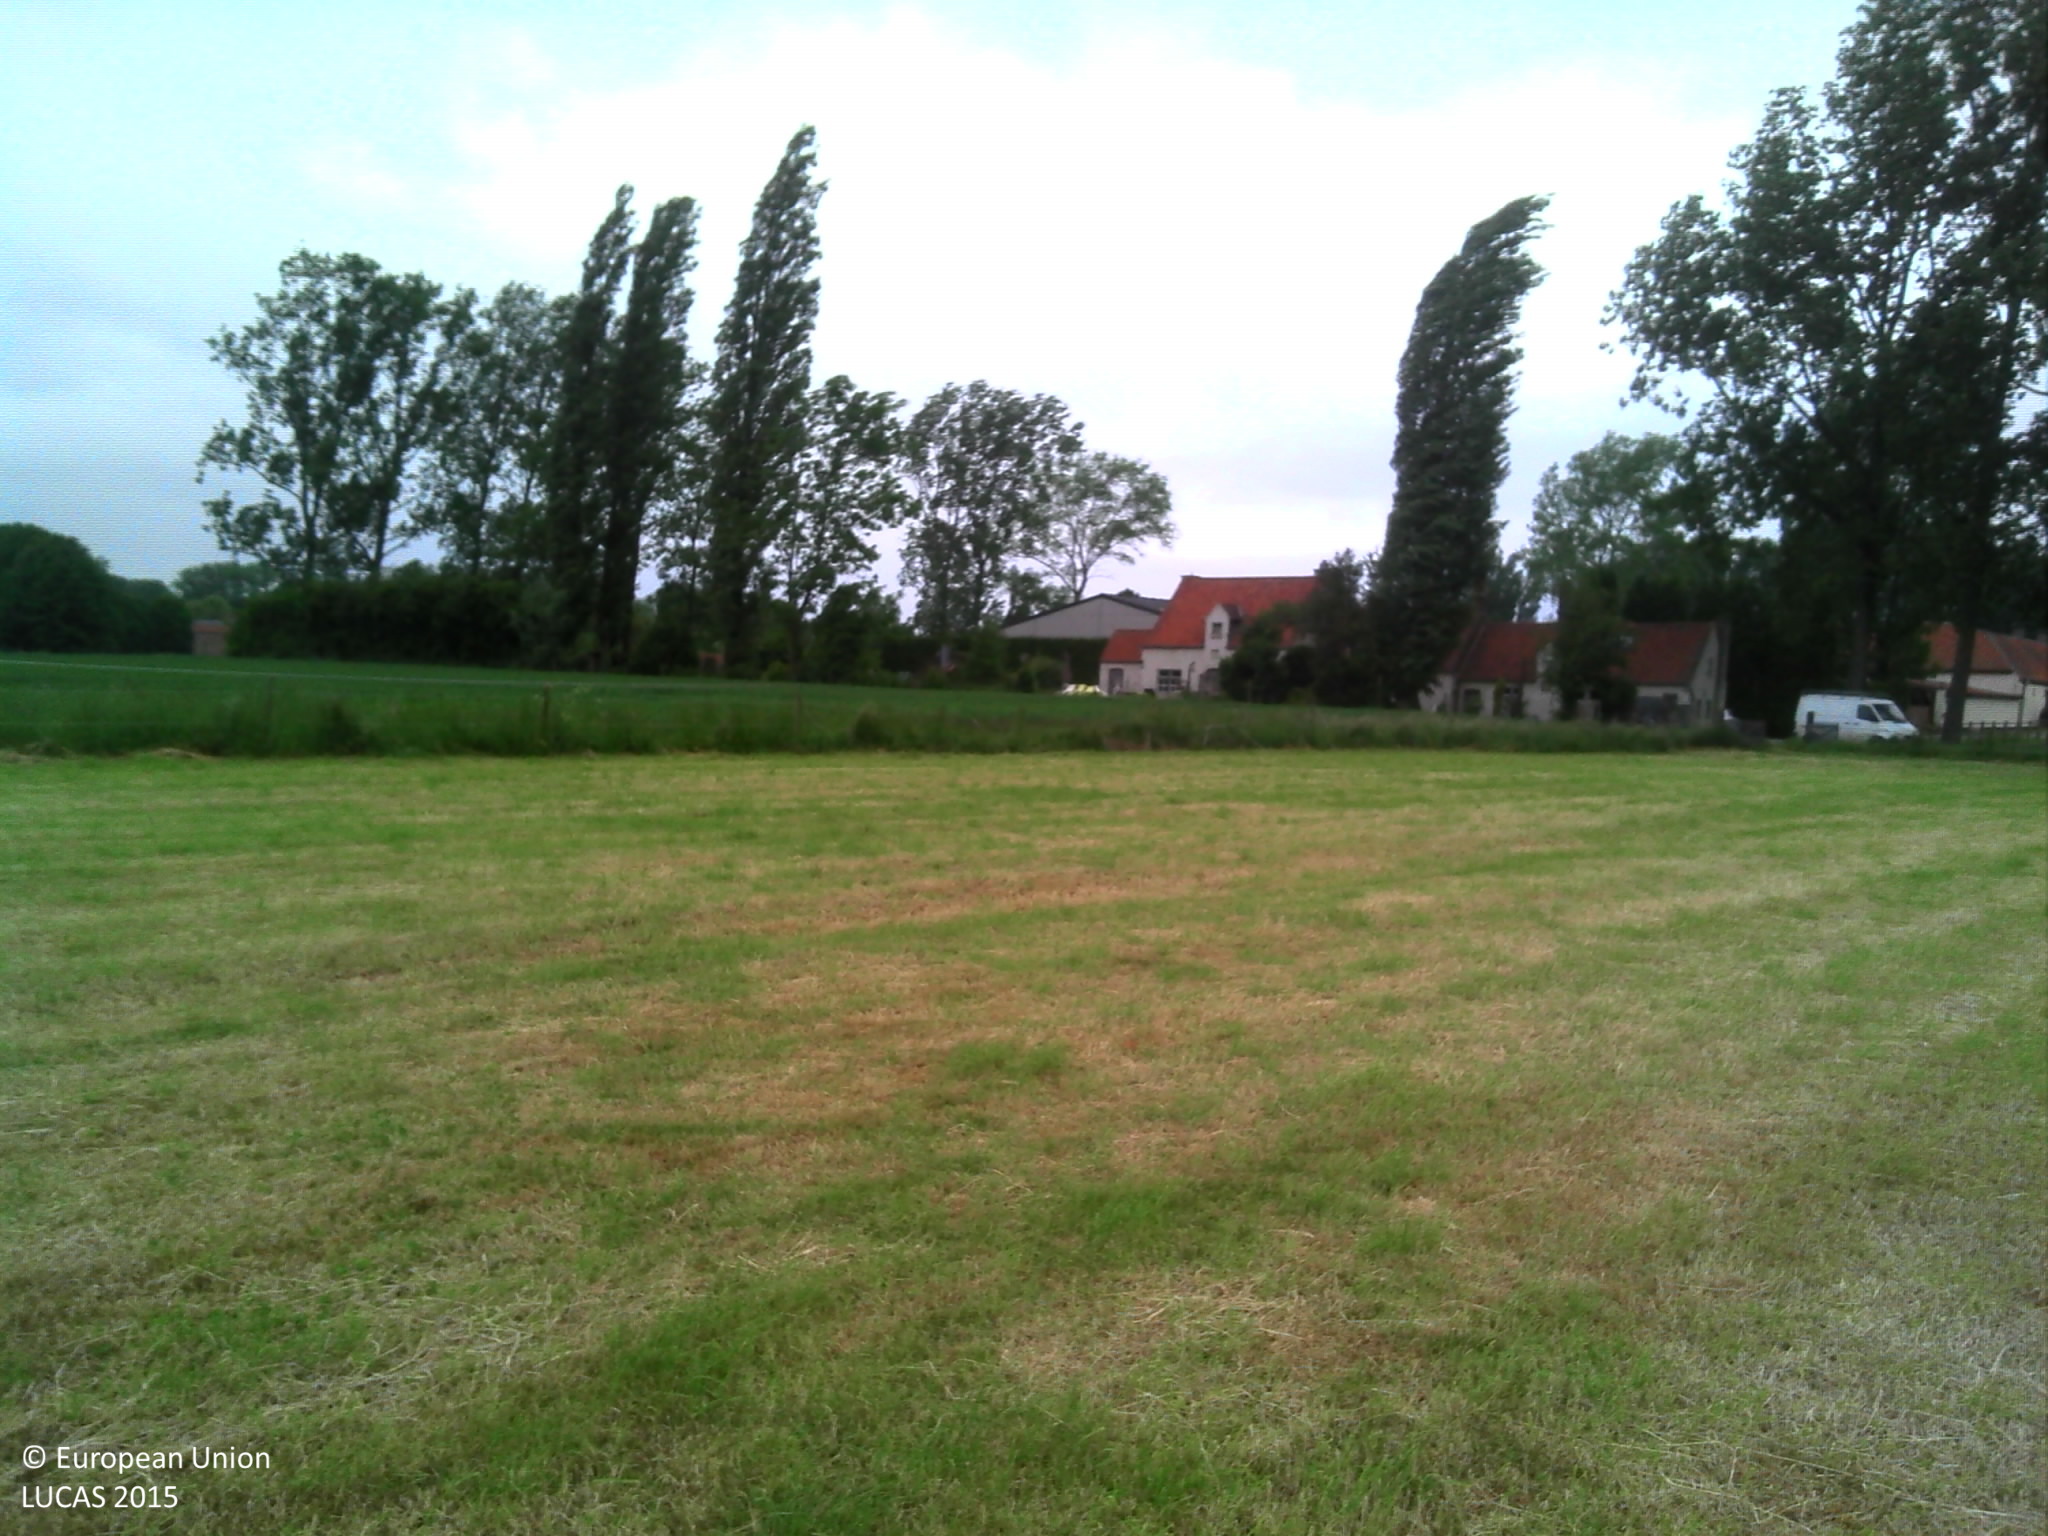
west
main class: Grassland
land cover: Grassland without tree/shrub cover
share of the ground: > 75 %
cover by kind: herbaceous plants 100 %
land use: Agriculture (excluding fallow land and kitchen gardens)
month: June
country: BE
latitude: 50.8474
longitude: 3.8436
